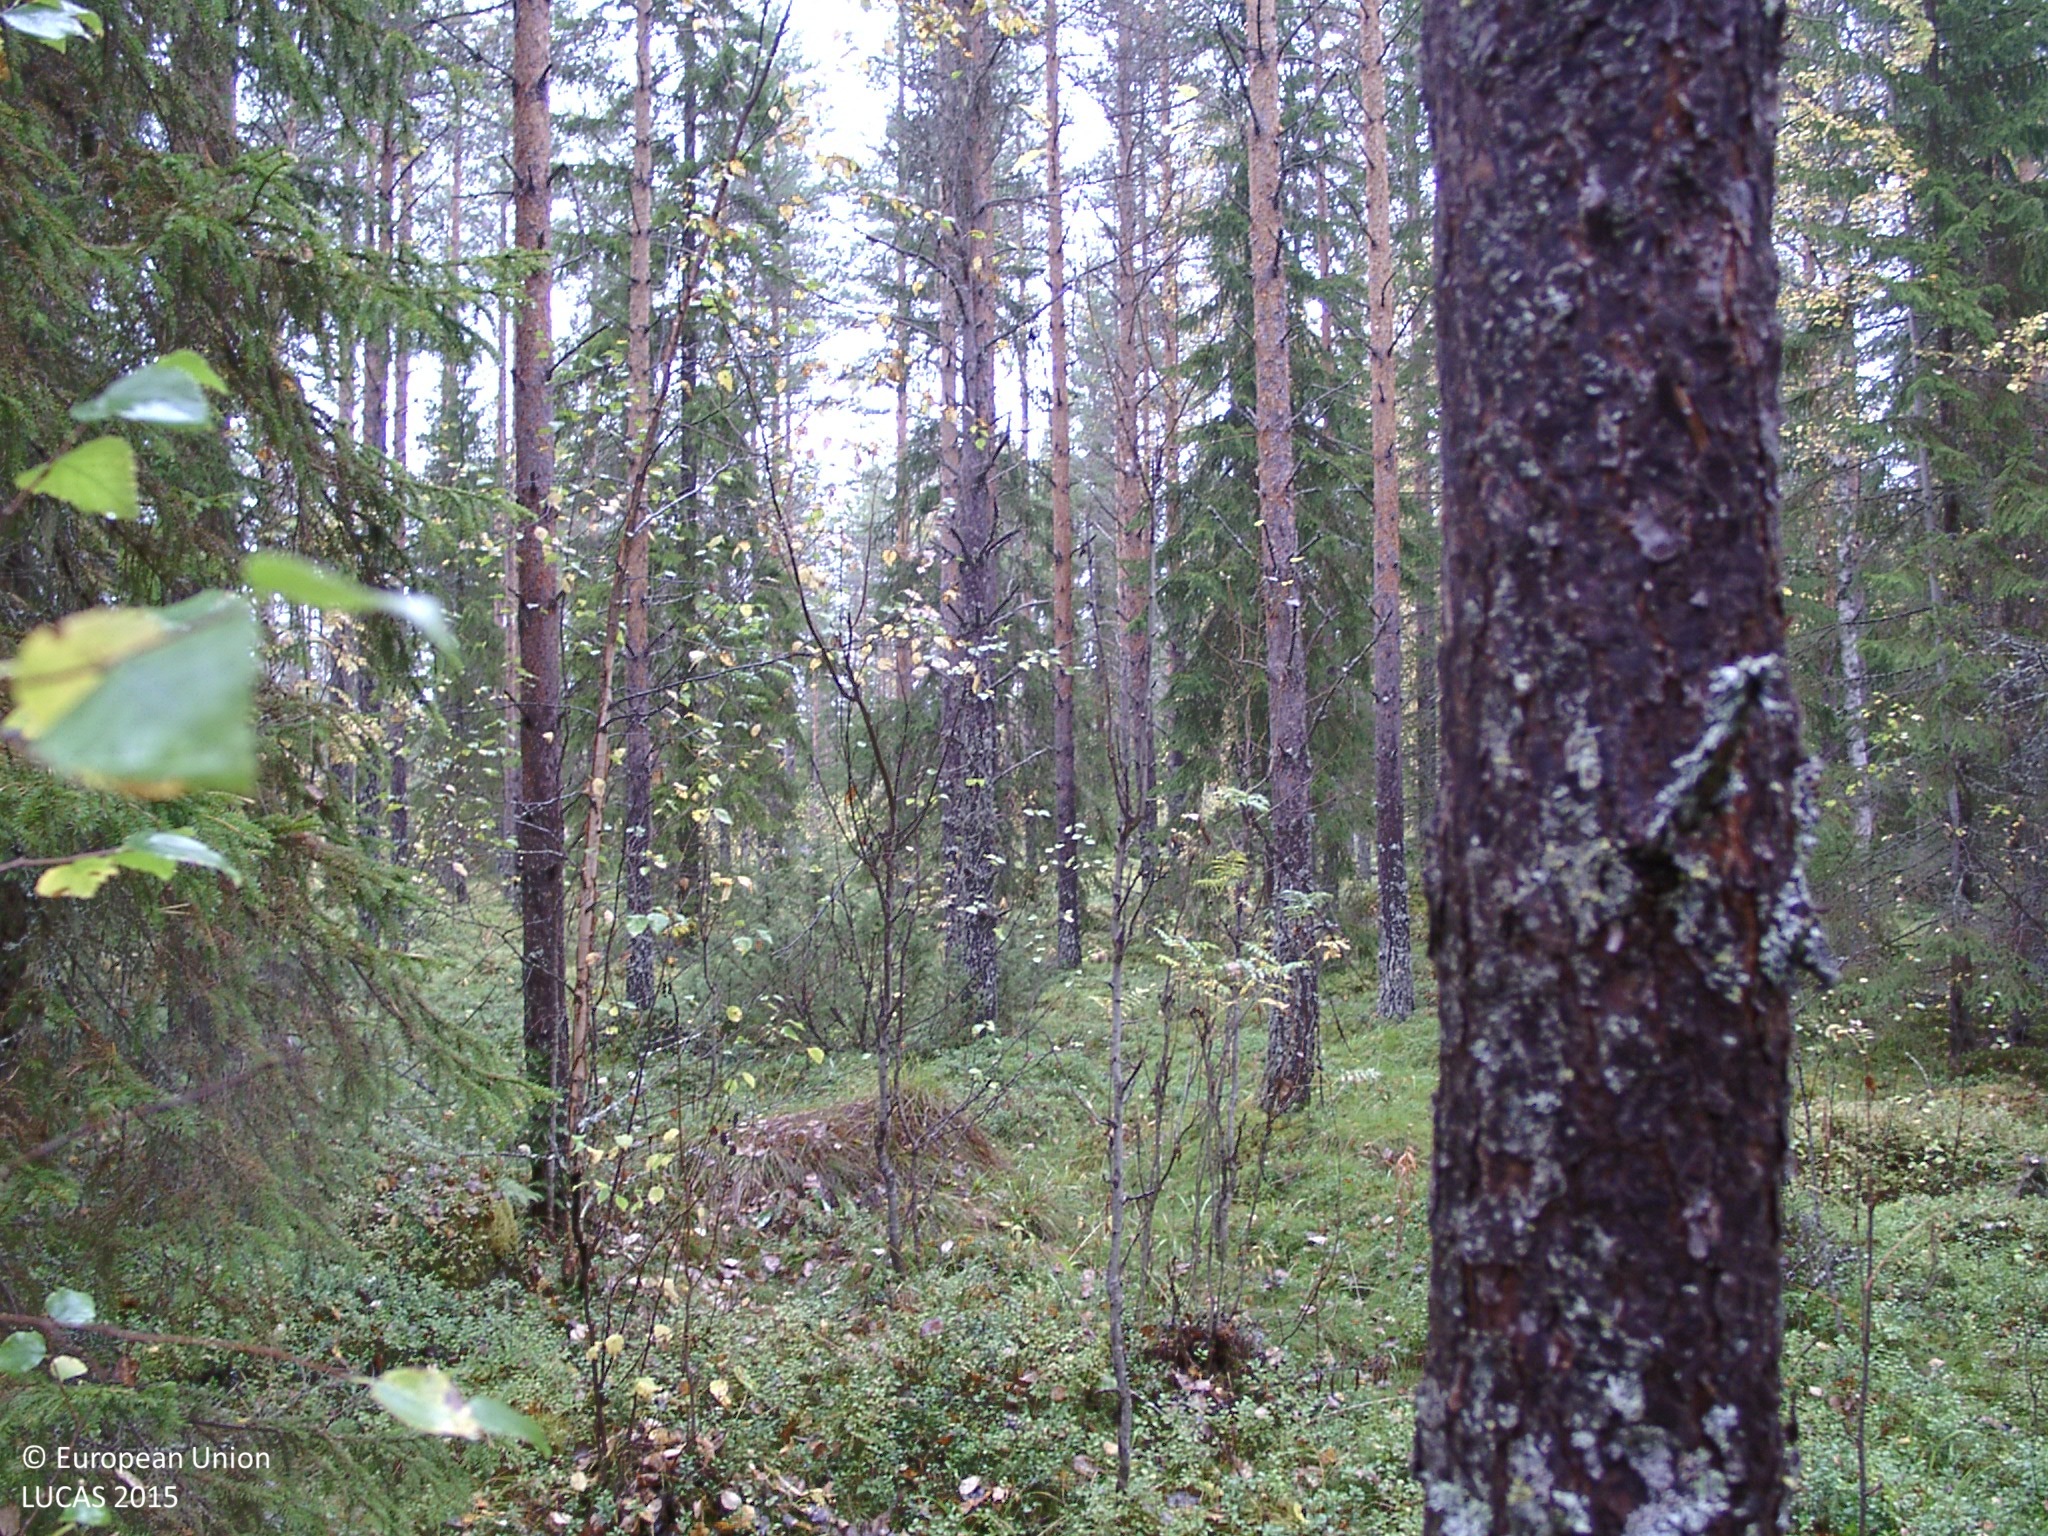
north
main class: Woodland
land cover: Other mixed woodland
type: boreal forest
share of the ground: 50 - 75 %
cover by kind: coniferous forest trees 40 %, shrubs 20 %, broadleaved forest trees 15 %, lichens and mosses 15 %, herbaceous plants 10 %
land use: Forestry
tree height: > 5 m
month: September
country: FI
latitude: 62.8335
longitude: 25.5200
